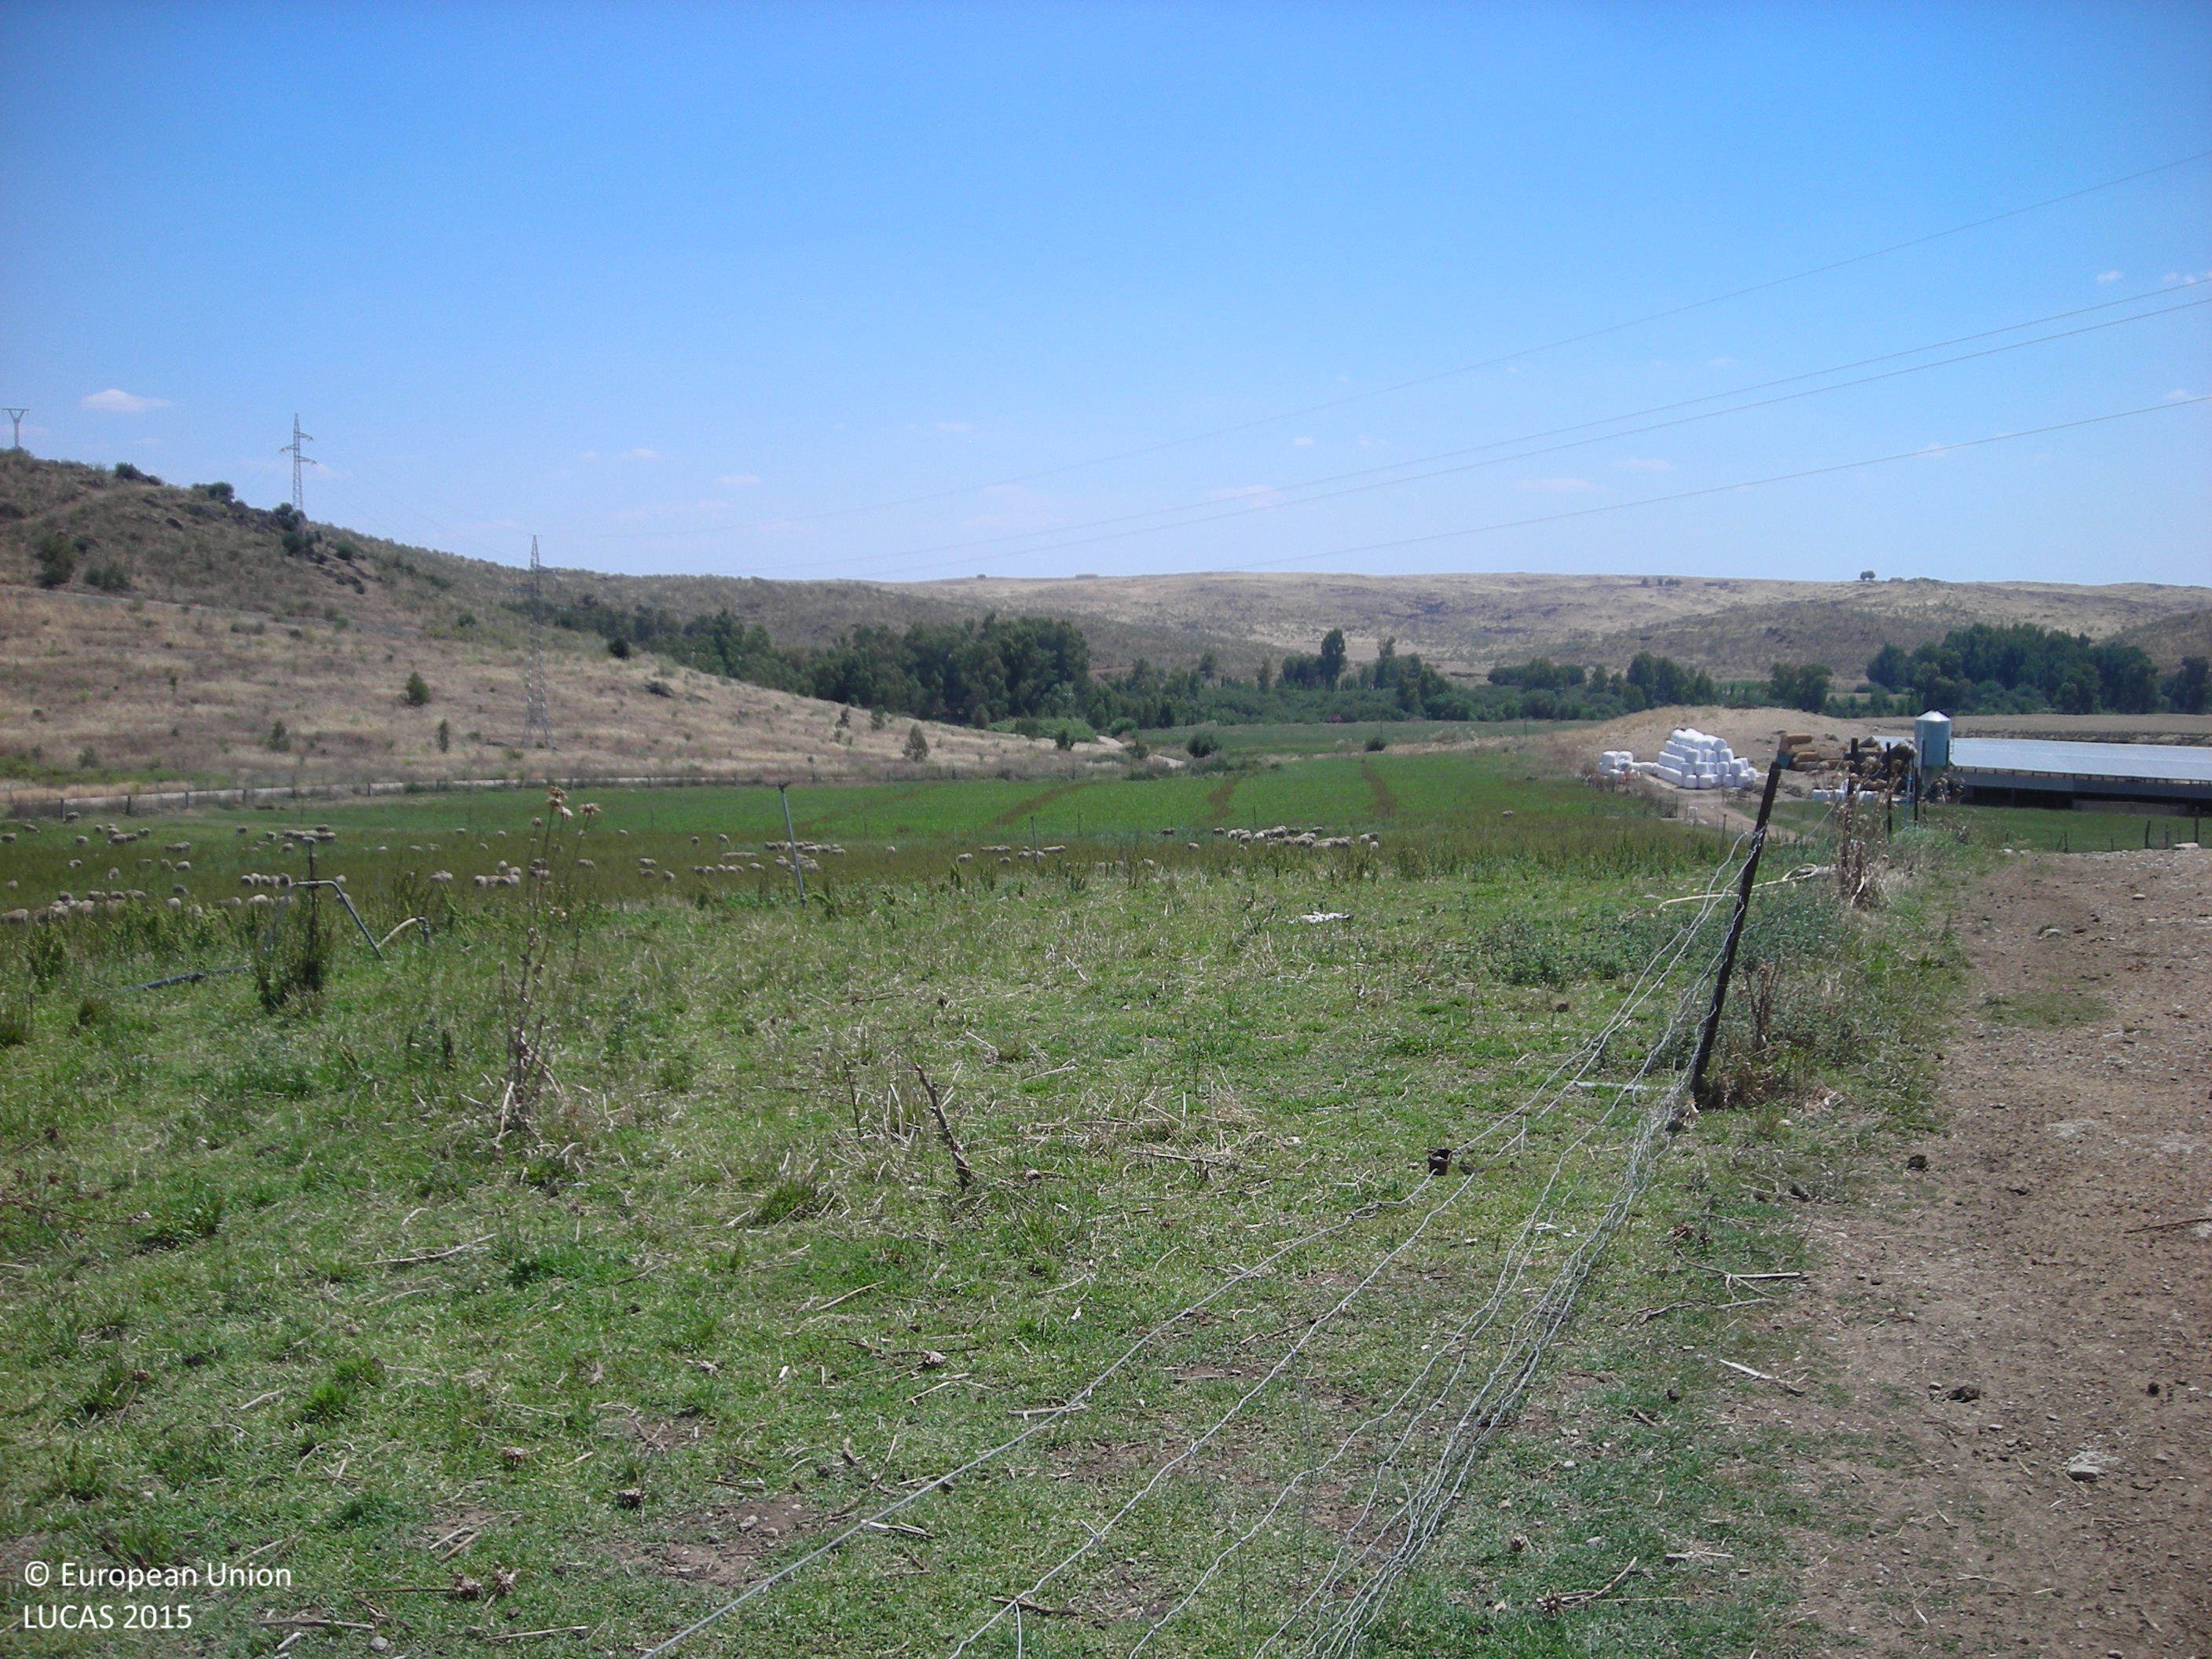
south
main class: Cropland
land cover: Mixed cereals for fodder
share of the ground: > 75 %
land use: Agriculture (excluding fallow land and kitchen gardens)
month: June
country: ES
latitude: 38.9191
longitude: -5.4856
